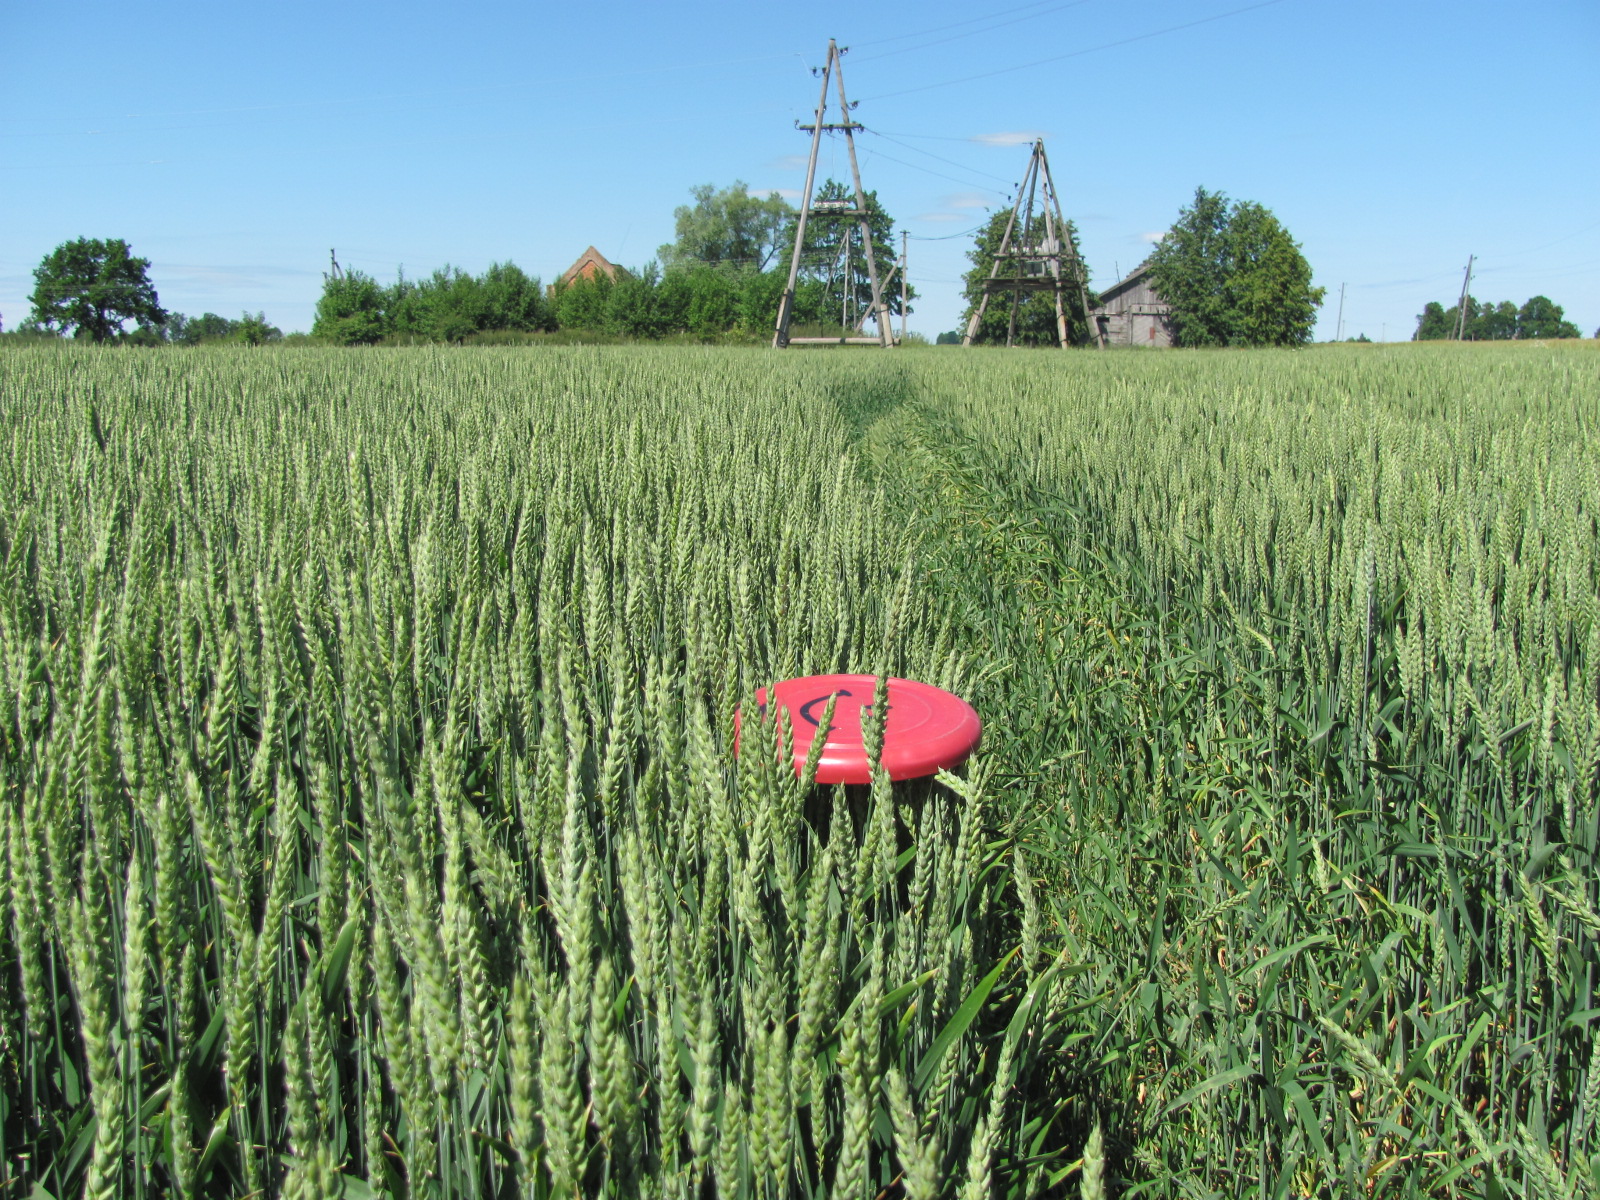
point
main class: Cropland
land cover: Common wheat
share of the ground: > 75 %
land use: Agriculture (excluding fallow land and kitchen gardens)
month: July
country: LV
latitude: 56.4471
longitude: 23.7561
